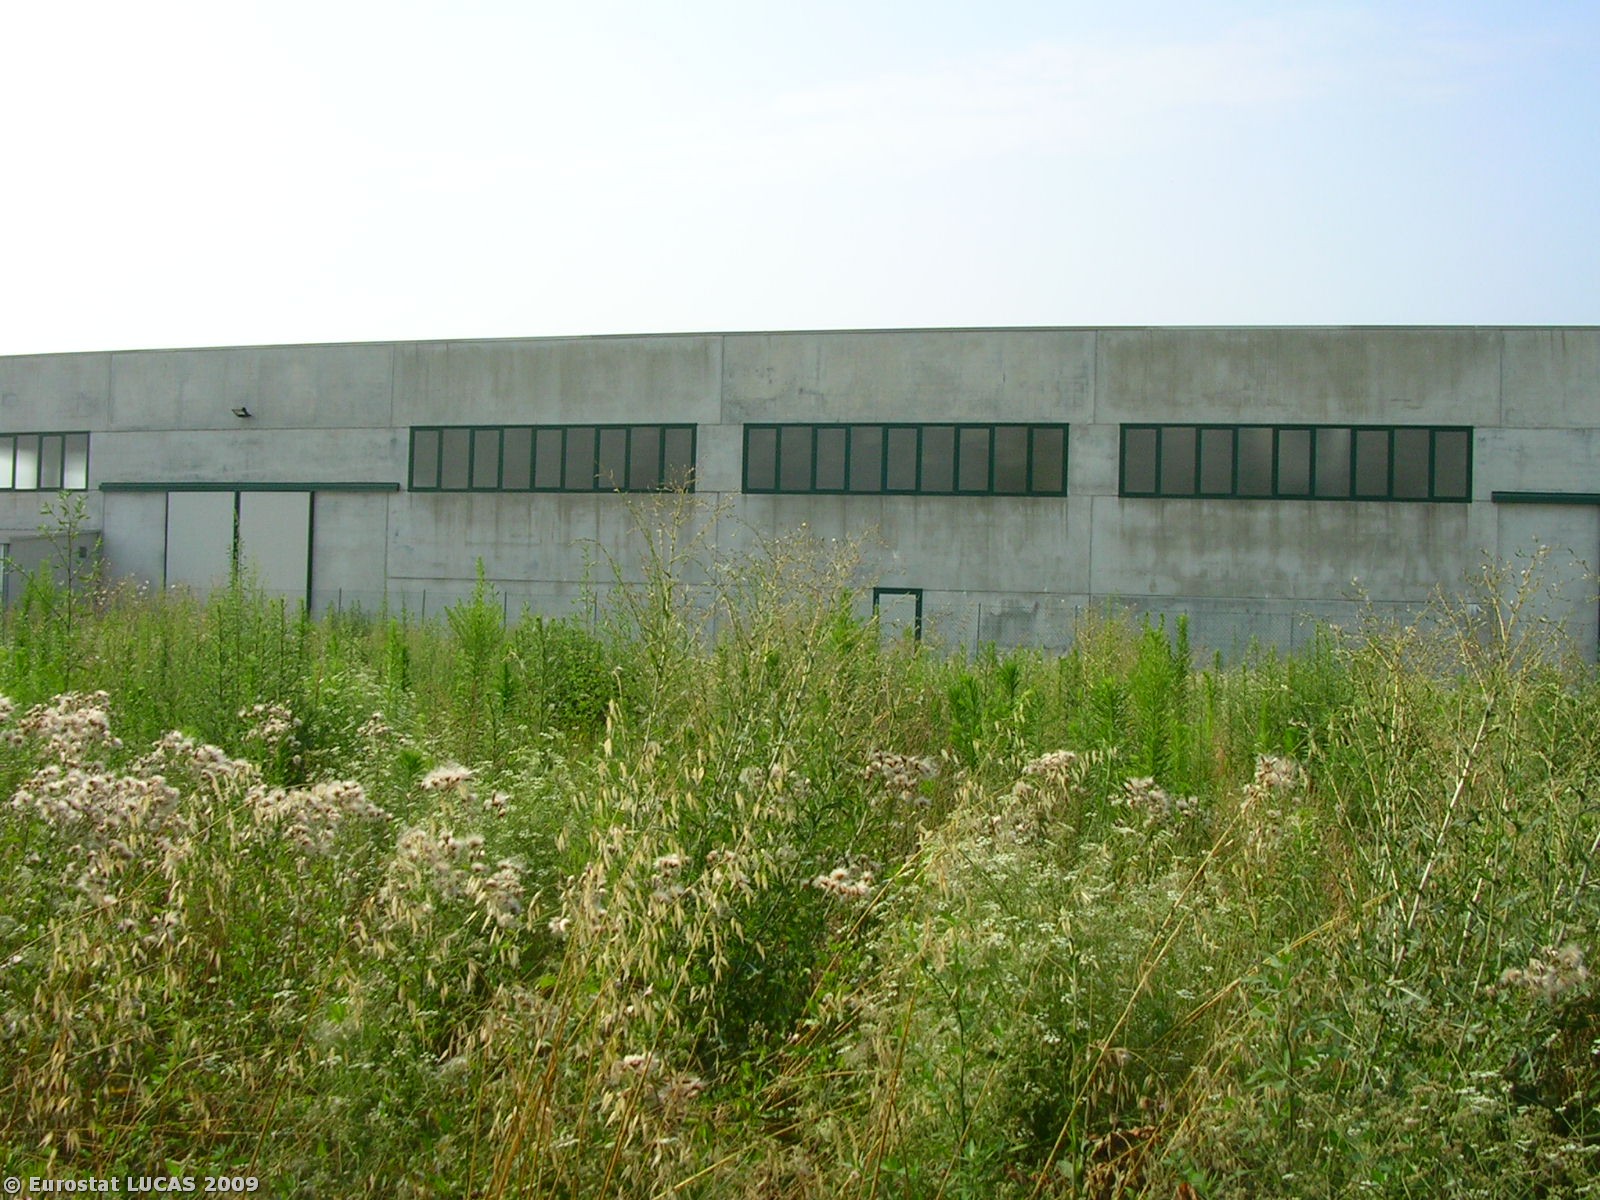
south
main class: Cropland
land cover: Vineyards
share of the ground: 50 - 75 %
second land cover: Bare land
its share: 50 - 75 %
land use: Agriculture (excluding fallow land and kitchen gardens)
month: July
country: IT
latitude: 45.2196
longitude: 11.7416
